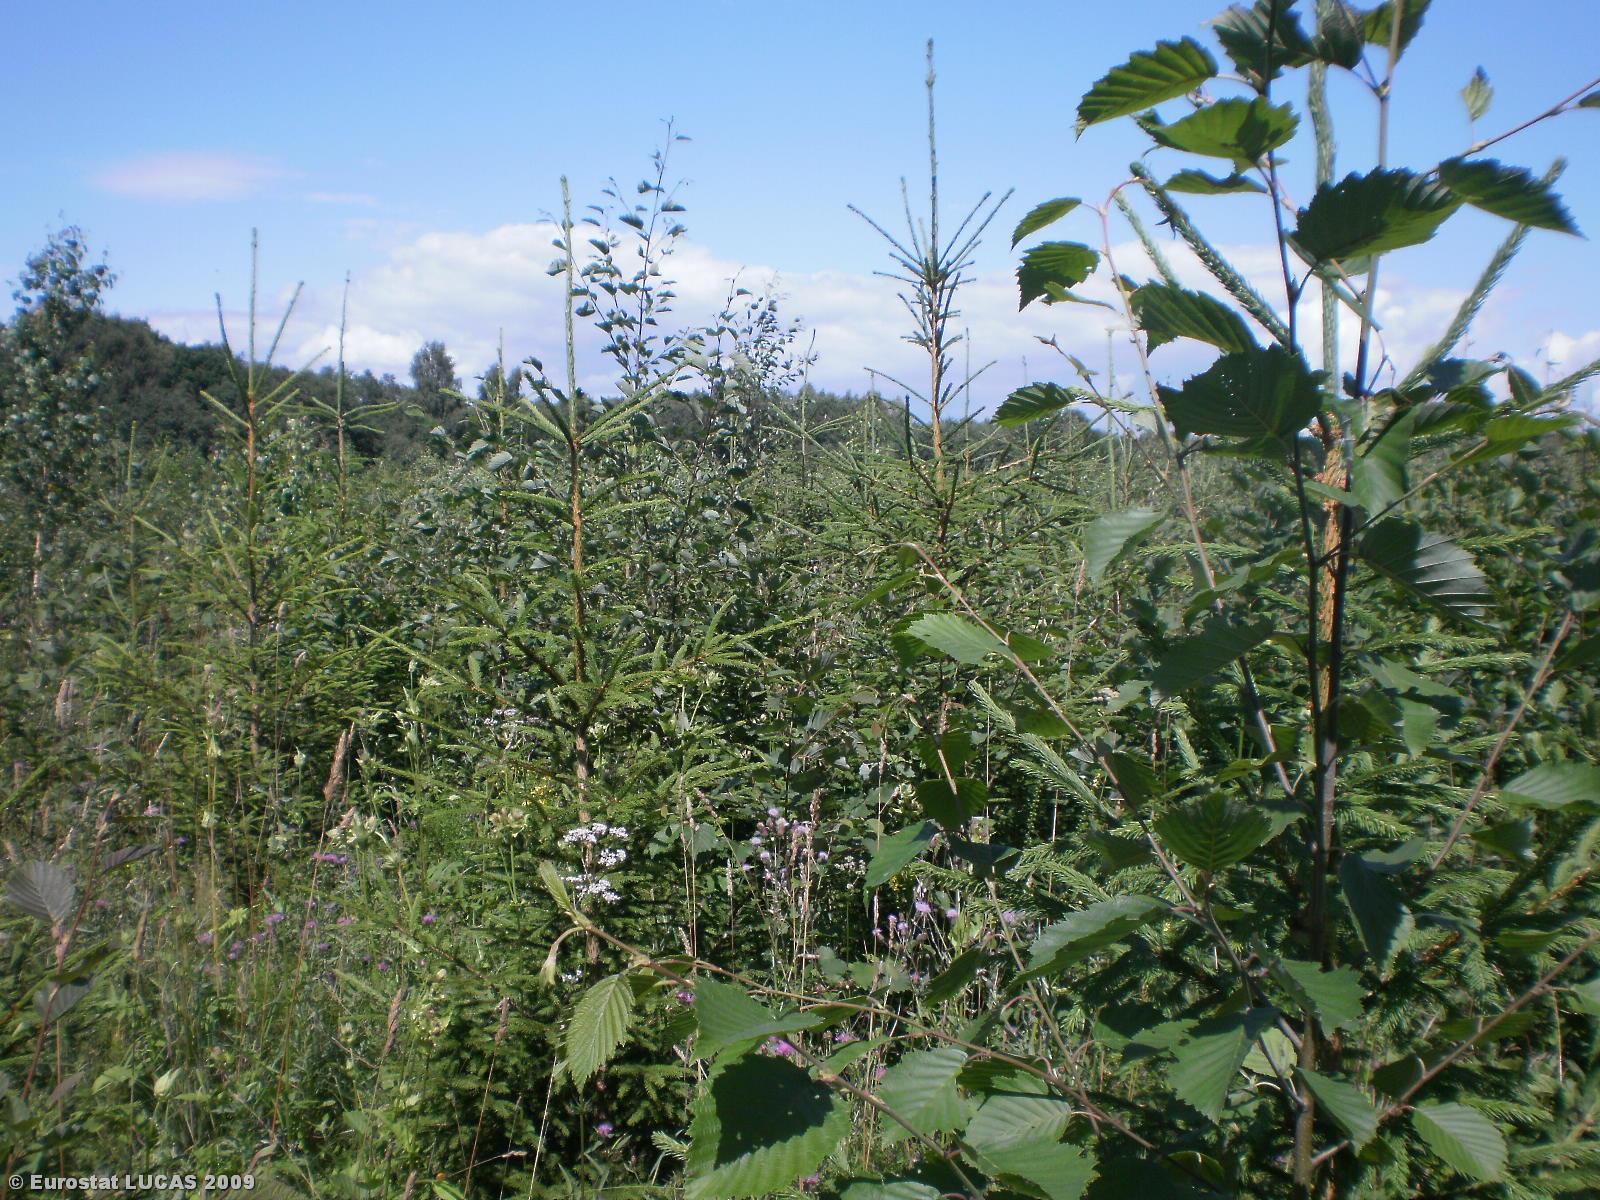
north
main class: Woodland
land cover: Mixed woodland
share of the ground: 25 - 50 %
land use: Forestry
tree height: < 5 m
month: July
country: LT
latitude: 55.9972
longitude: 25.1367
